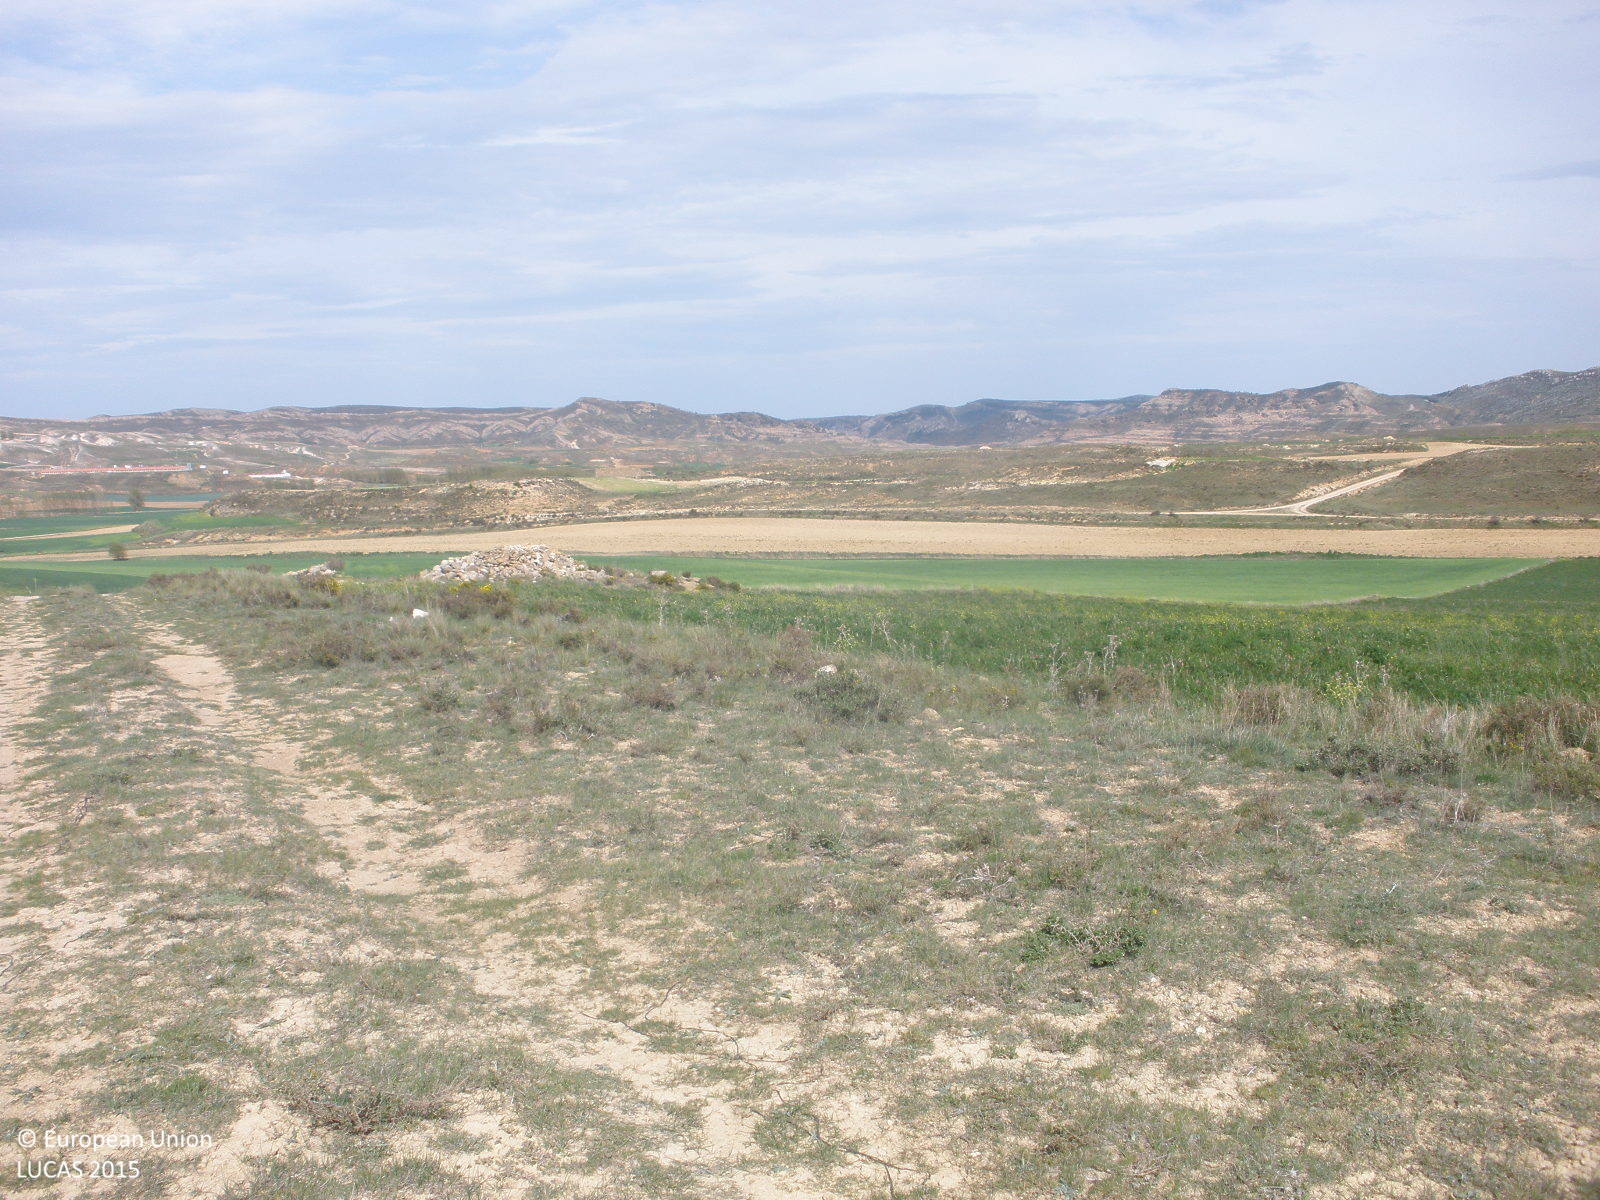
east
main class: Shrubland
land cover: Shrubland without tree cover
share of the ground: 25 - 50 %
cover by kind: herbaceous plants 50 %, shrubs 30 %, consolidated bare surface 20 %
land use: Semi-natural and natural areas not in use
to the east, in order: Artificial constructions in urban areas; Shrubland without tree cover; Spontaneously vegetated surfaces; Grass margins; Rye
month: May
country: ES
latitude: 40.6734
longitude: -0.7892
